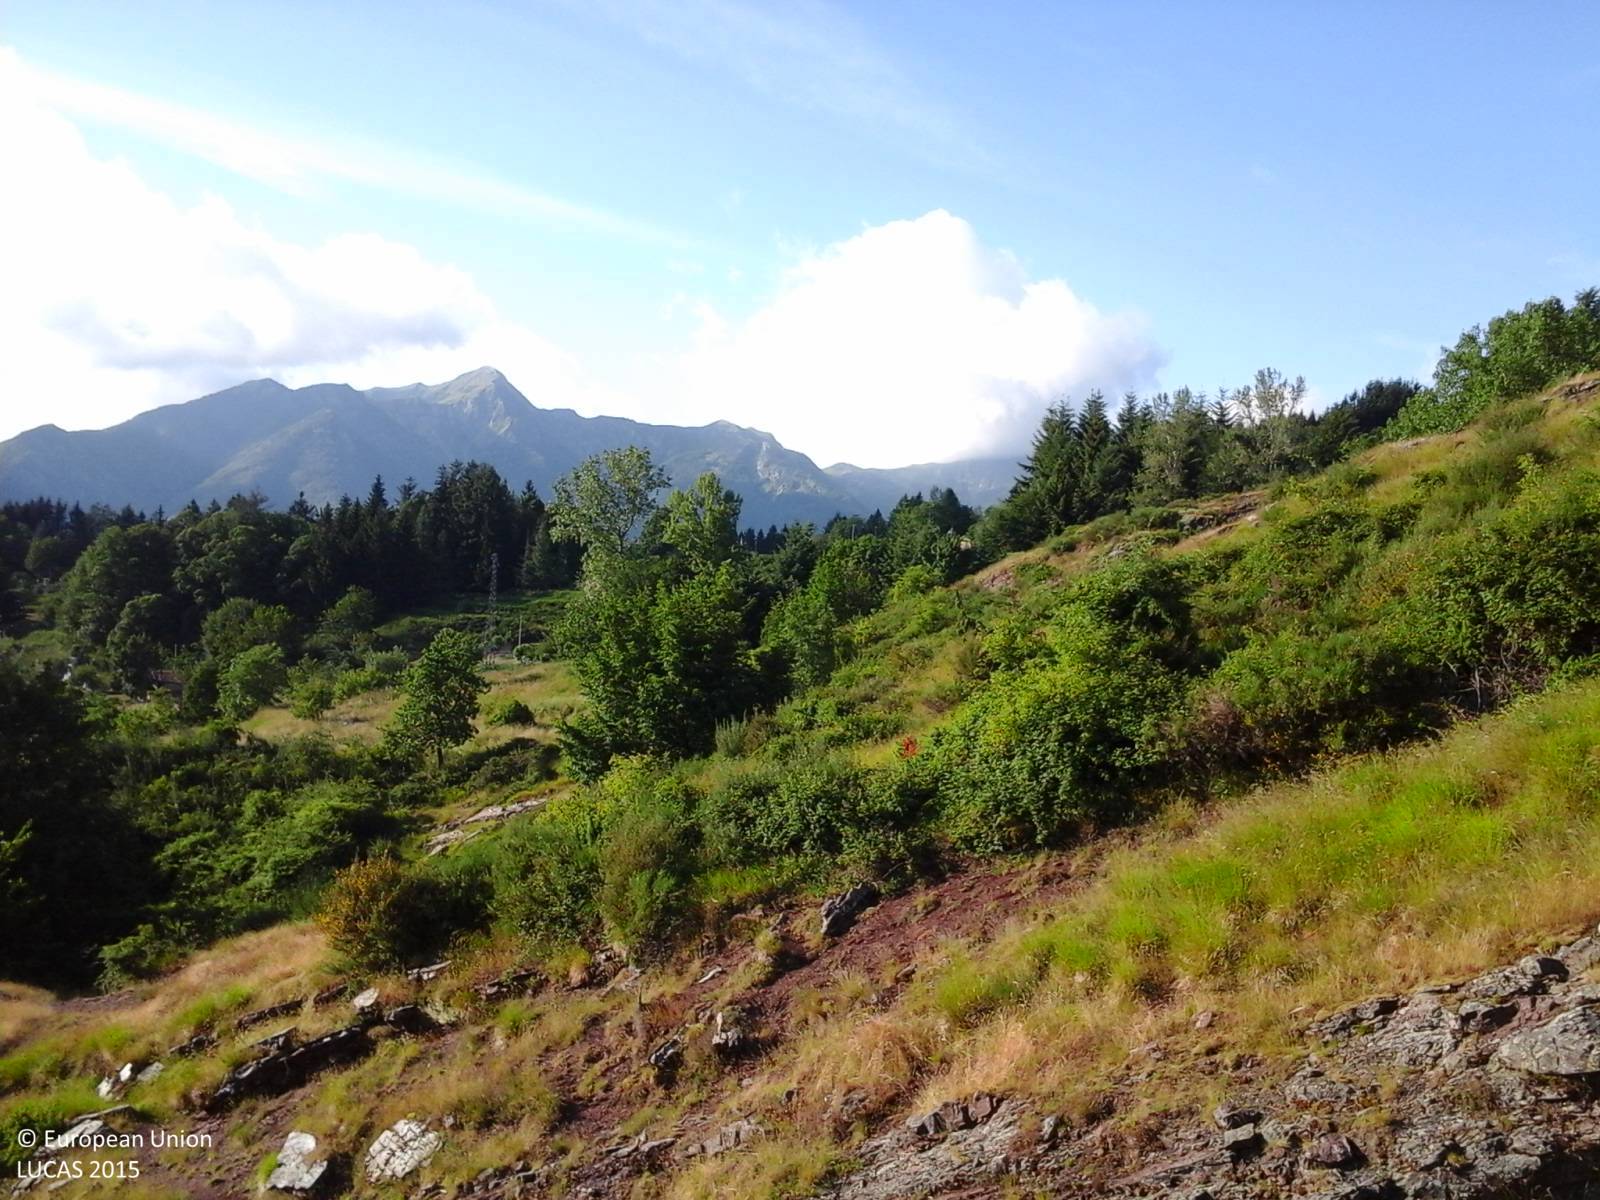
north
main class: Shrubland
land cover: Shrubland without tree cover
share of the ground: > 75 %
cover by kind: shrubs 50 %, herbaceous plants 30 %, consolidated bare surface 20 %
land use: Semi-natural and natural areas not in use
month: June
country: IT
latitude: 44.0601
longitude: 10.6102
